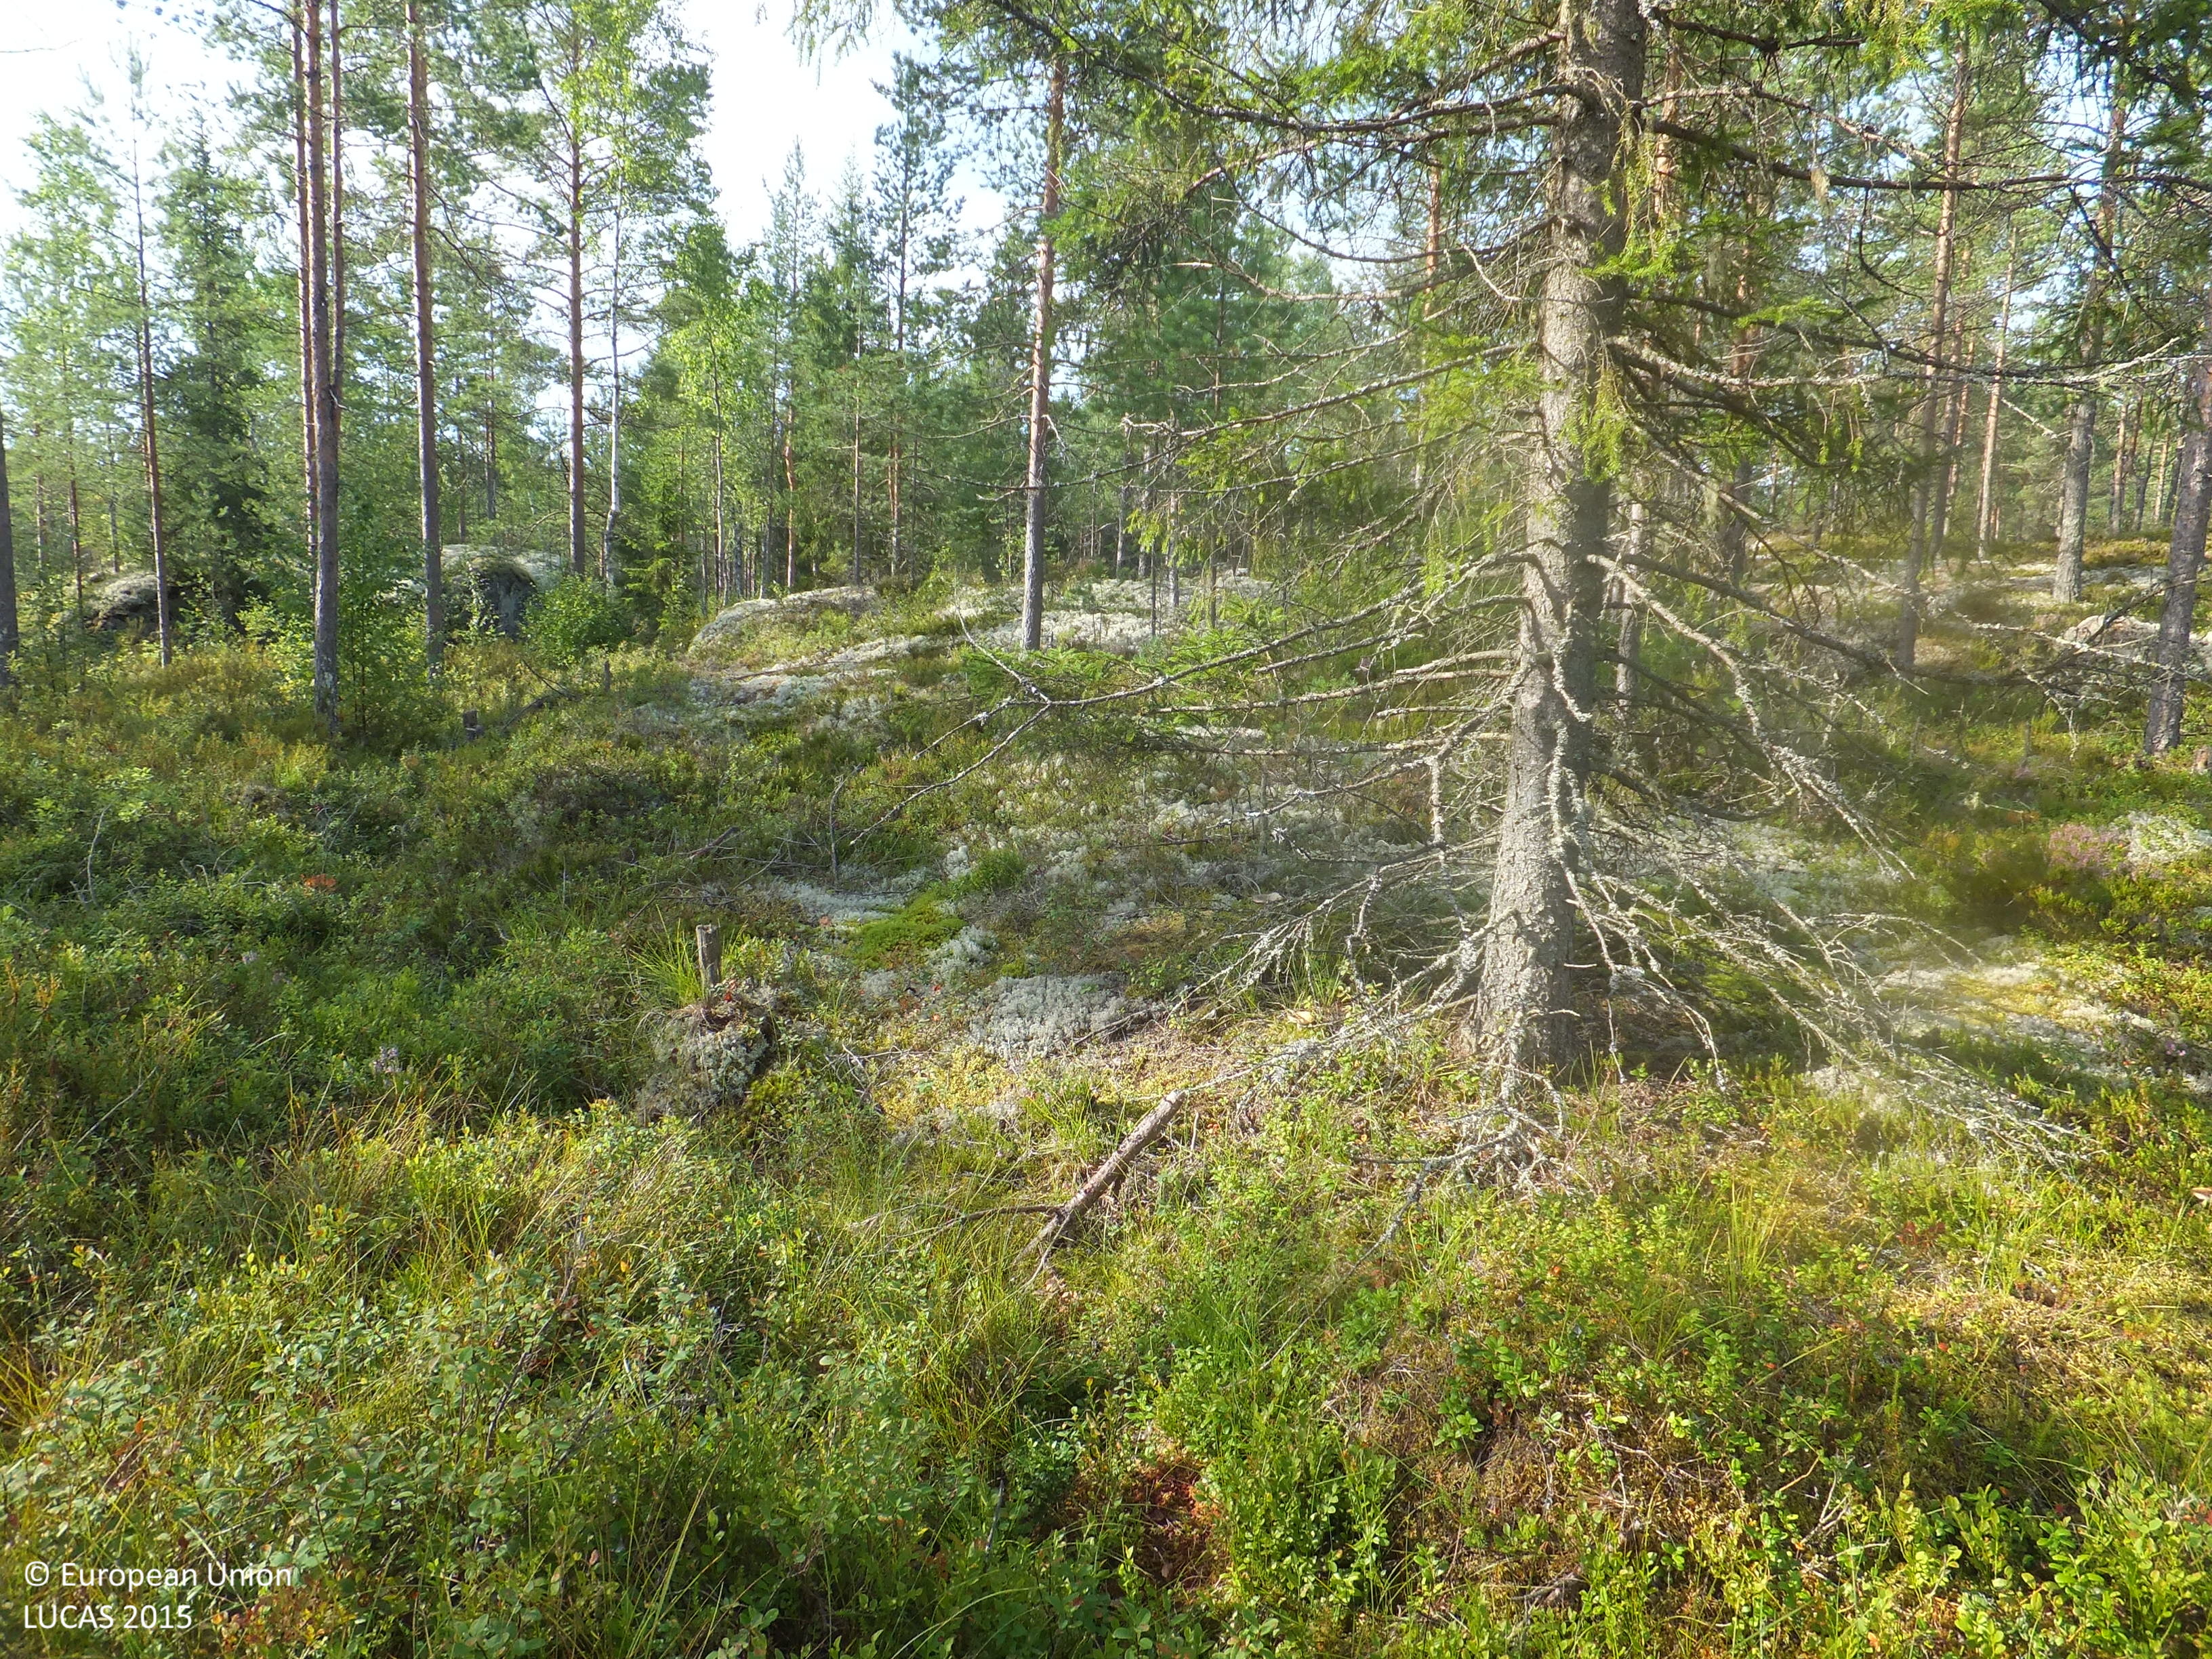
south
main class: Woodland
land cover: Pine dominated coniferous woodland
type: boreal forest
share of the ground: 25 - 50 %
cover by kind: coniferous forest trees 35 %, shrubs 30 %, lichens and mosses 15 %, herbaceous plants 10 %, broadleaved forest trees 5 %, consolidated bare surface 5 %
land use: Forestry
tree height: > 5 m
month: August
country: FI
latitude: 63.1442
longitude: 23.0142
